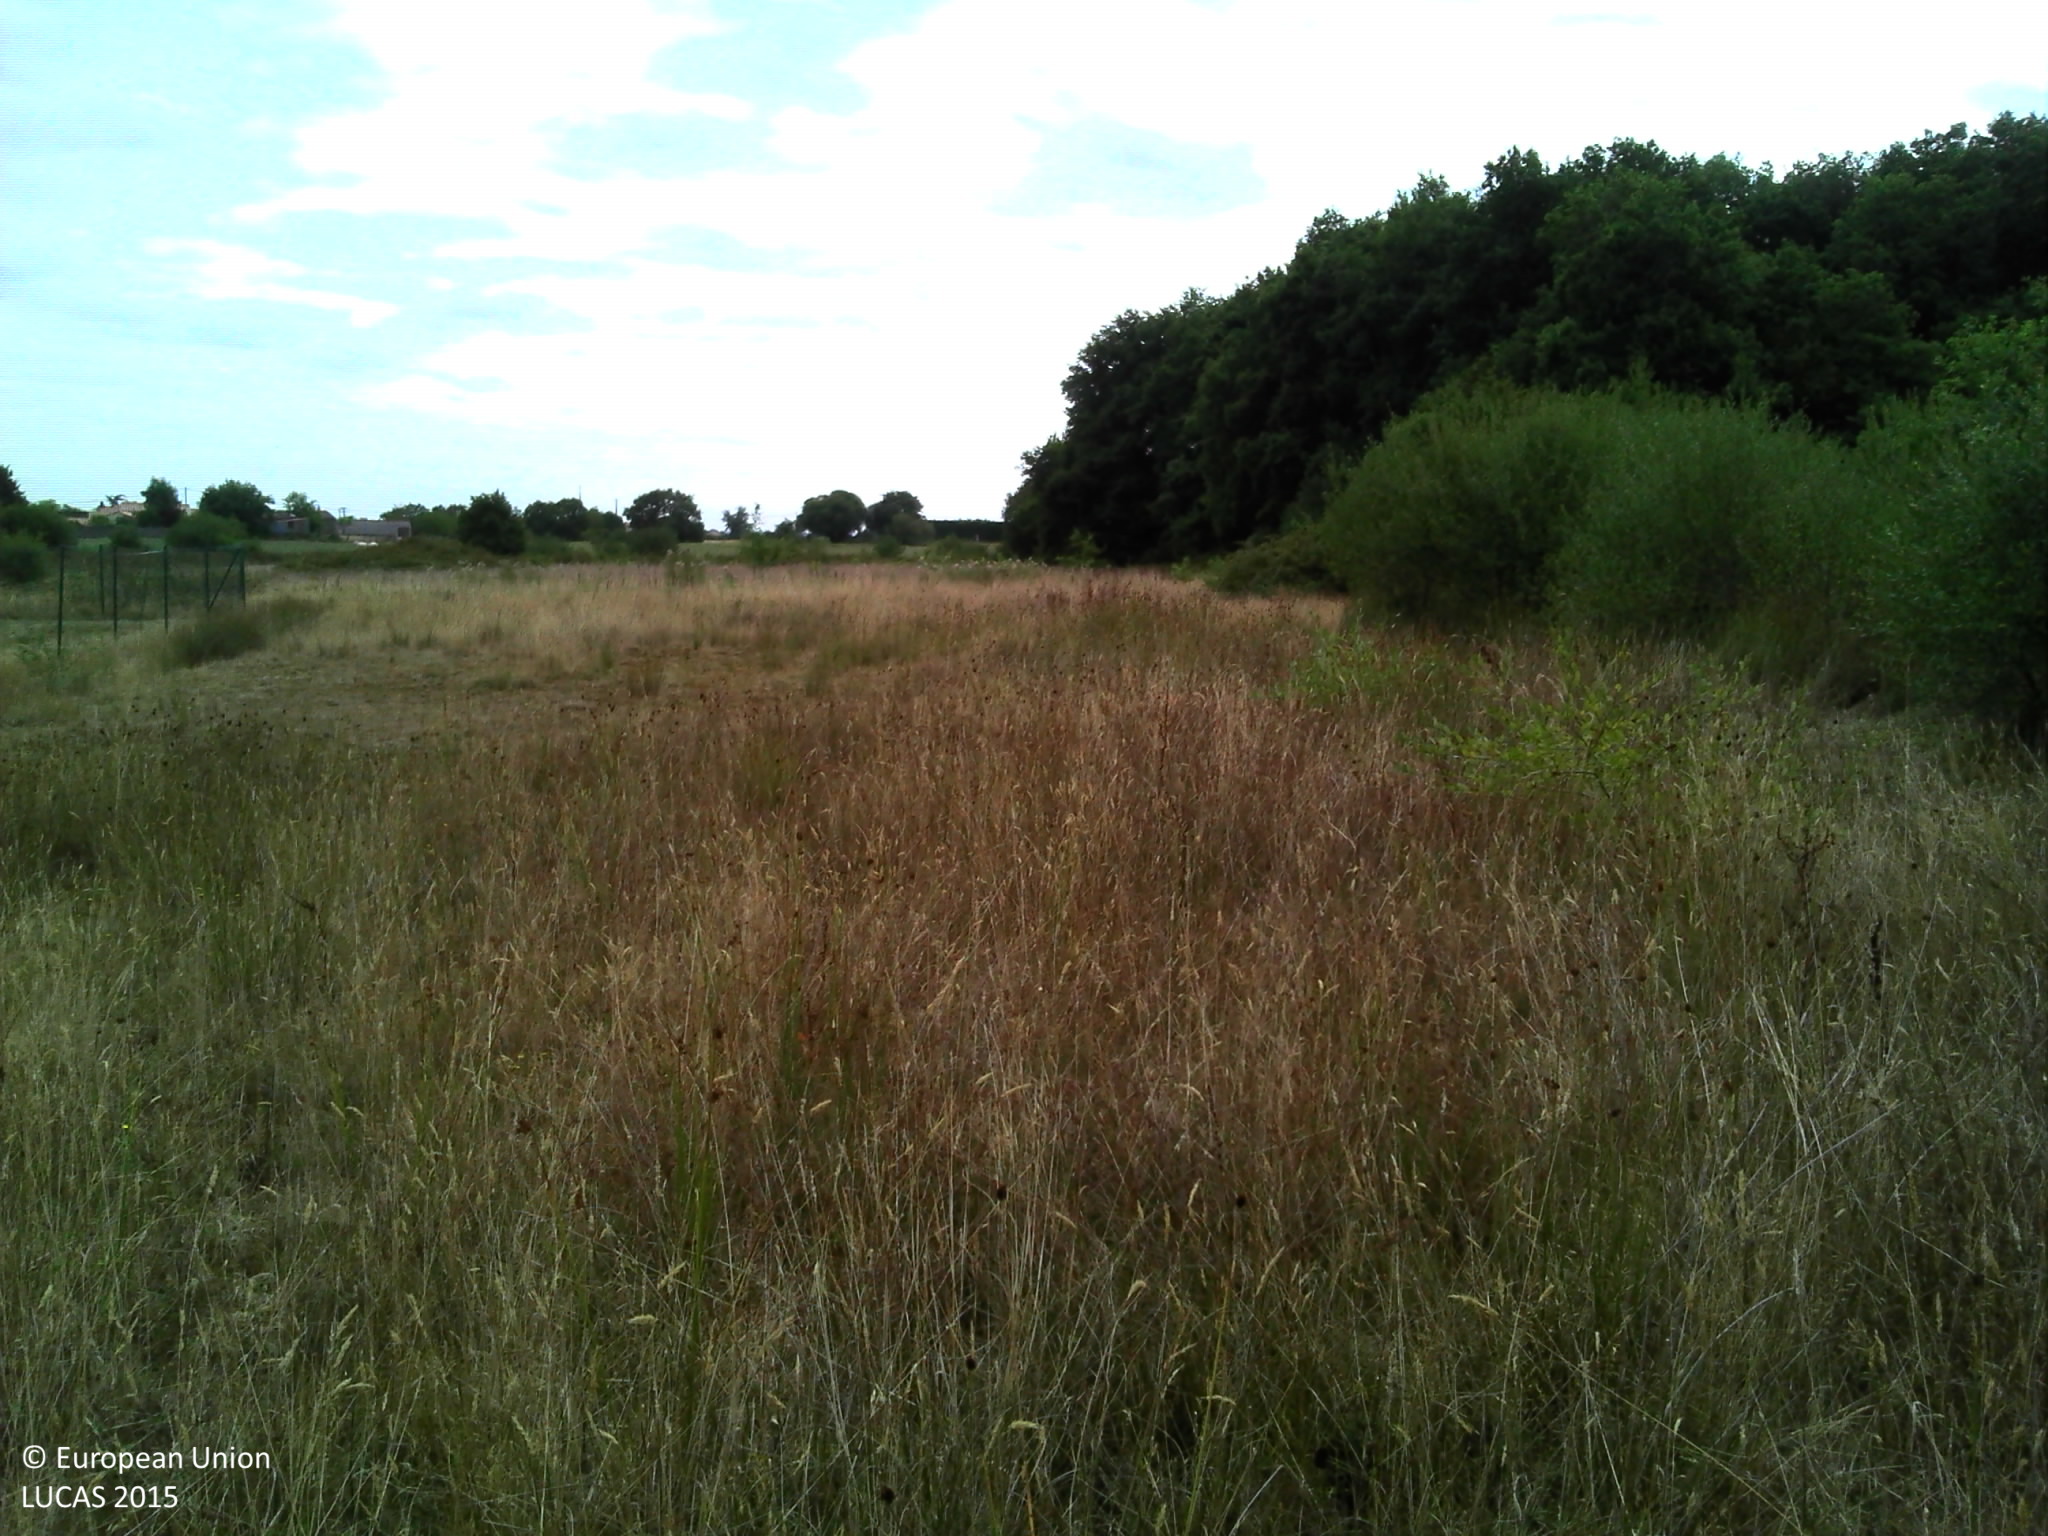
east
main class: Grassland
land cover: Grassland without tree/shrub cover
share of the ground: > 75 %
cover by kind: herbaceous plants 95 %, shrubs 5 %
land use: Semi-natural and natural areas not in use
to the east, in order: Grassland without tree/shrub cover; Broadleaved woodland; Ditches and canals; Fences; Grassland without tree/shrub cover; Fences; Spontaneously vegetated surfaces; Inland fresh water bodies; Single bushes/trees; Spontaneously vegetated surfaces; Fences; Grassland without tree/shrub cover
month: August
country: FR
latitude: 47.0486
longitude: -1.3991
